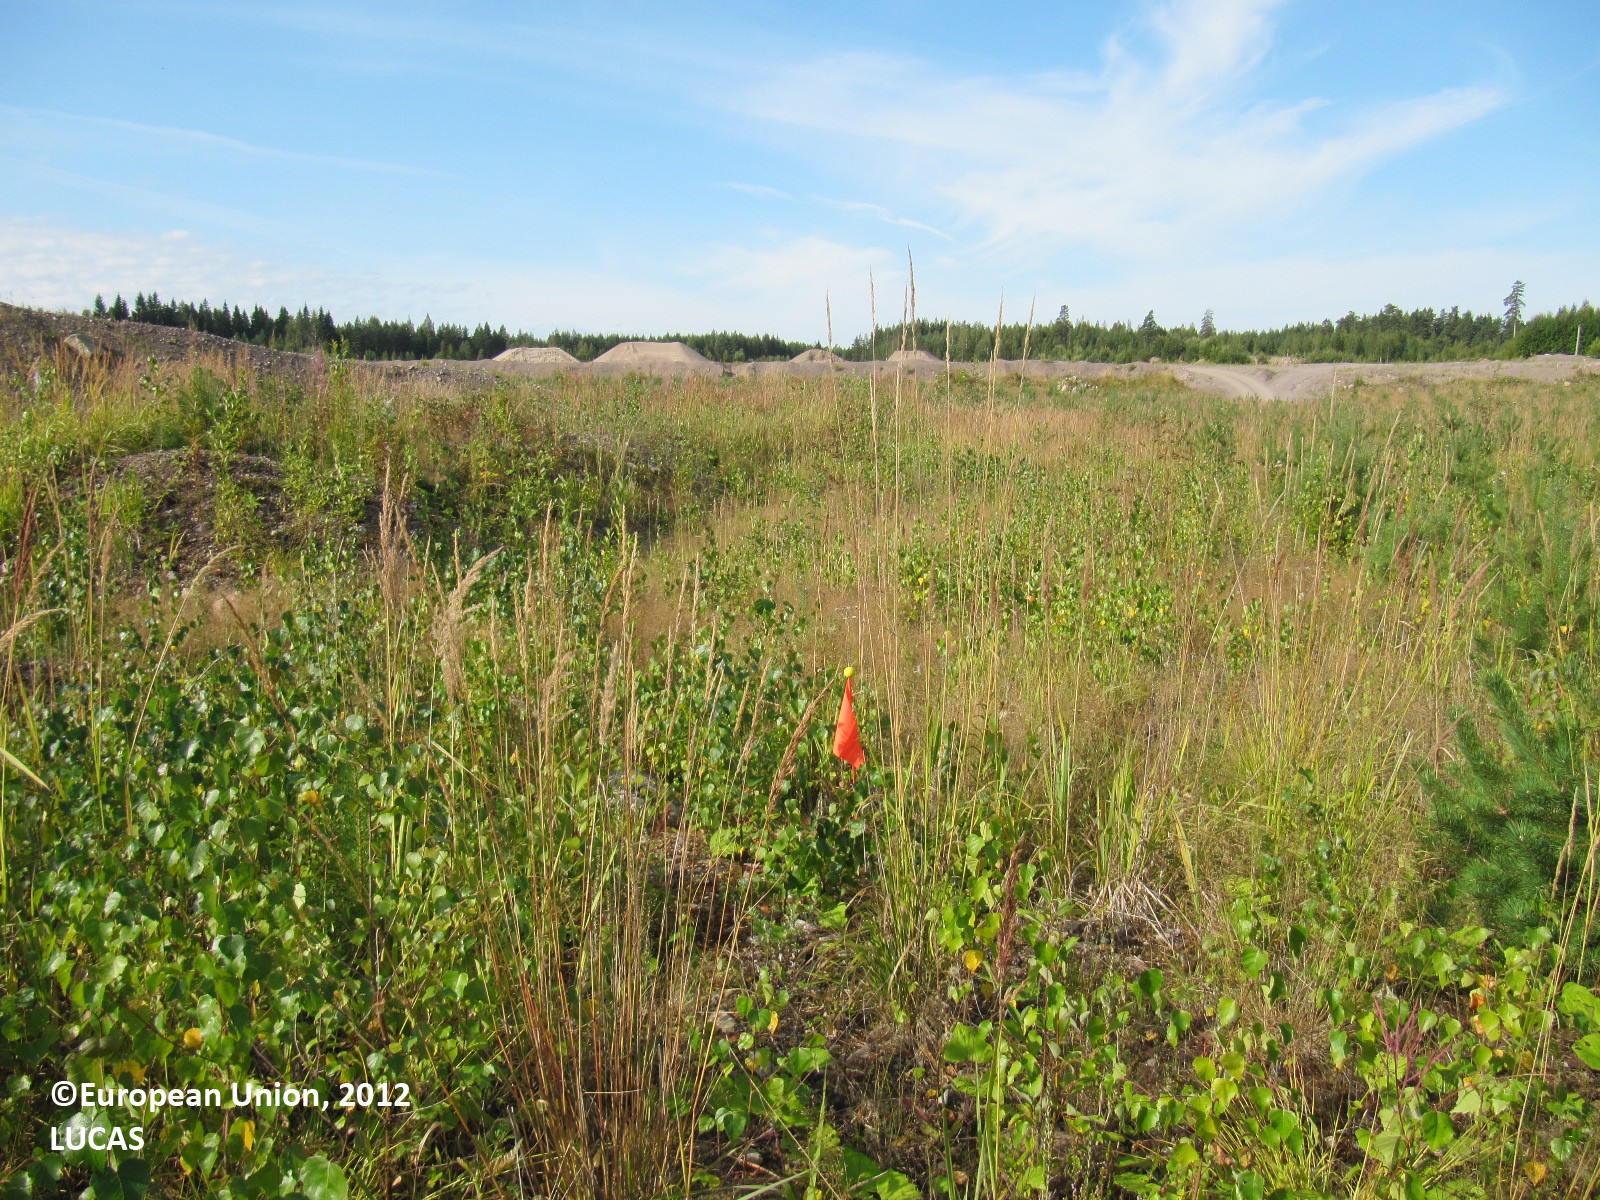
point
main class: Woodland
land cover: Other mixed woodland
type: boreal forest
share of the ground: > 75 %
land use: Mining and quarrying
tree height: < 5 m
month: August
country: FI
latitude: 60.5148
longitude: 24.4392
